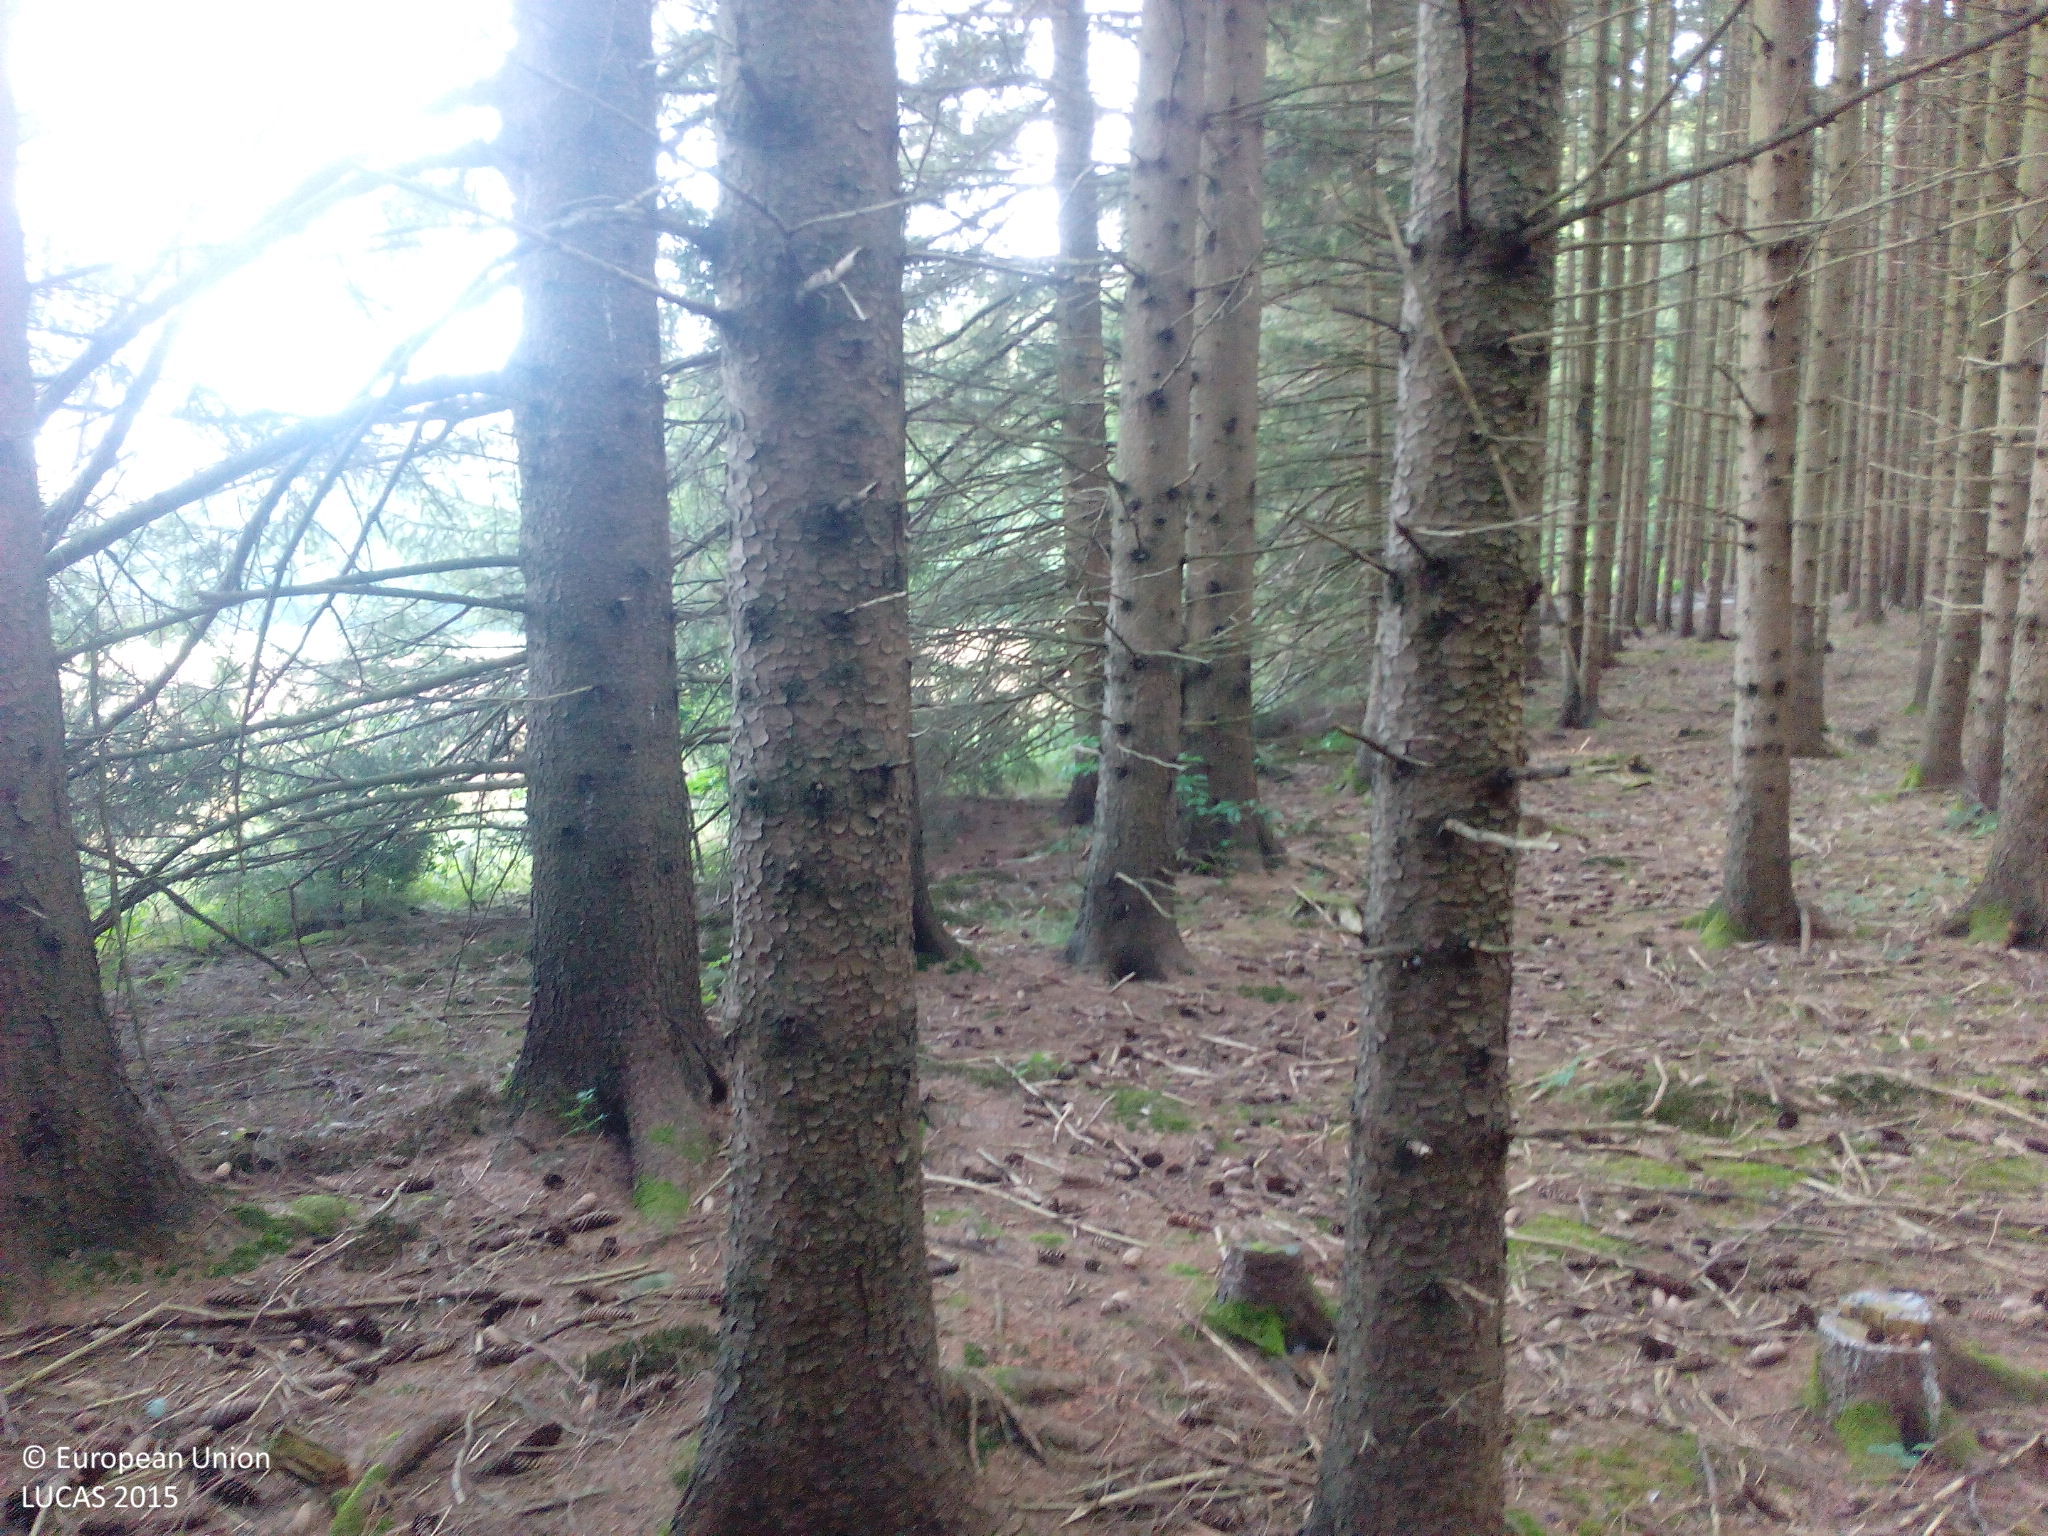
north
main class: Woodland
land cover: Spruce dominated coniferous woodland
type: hemiboreal forest and nemoral coniferous forest and mixed broadleaved-coniferous forest
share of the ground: > 75 %
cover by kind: coniferous forest trees 100 %
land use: Forestry
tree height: > 5 m
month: July
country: DE
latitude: 47.9855
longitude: 10.9507
